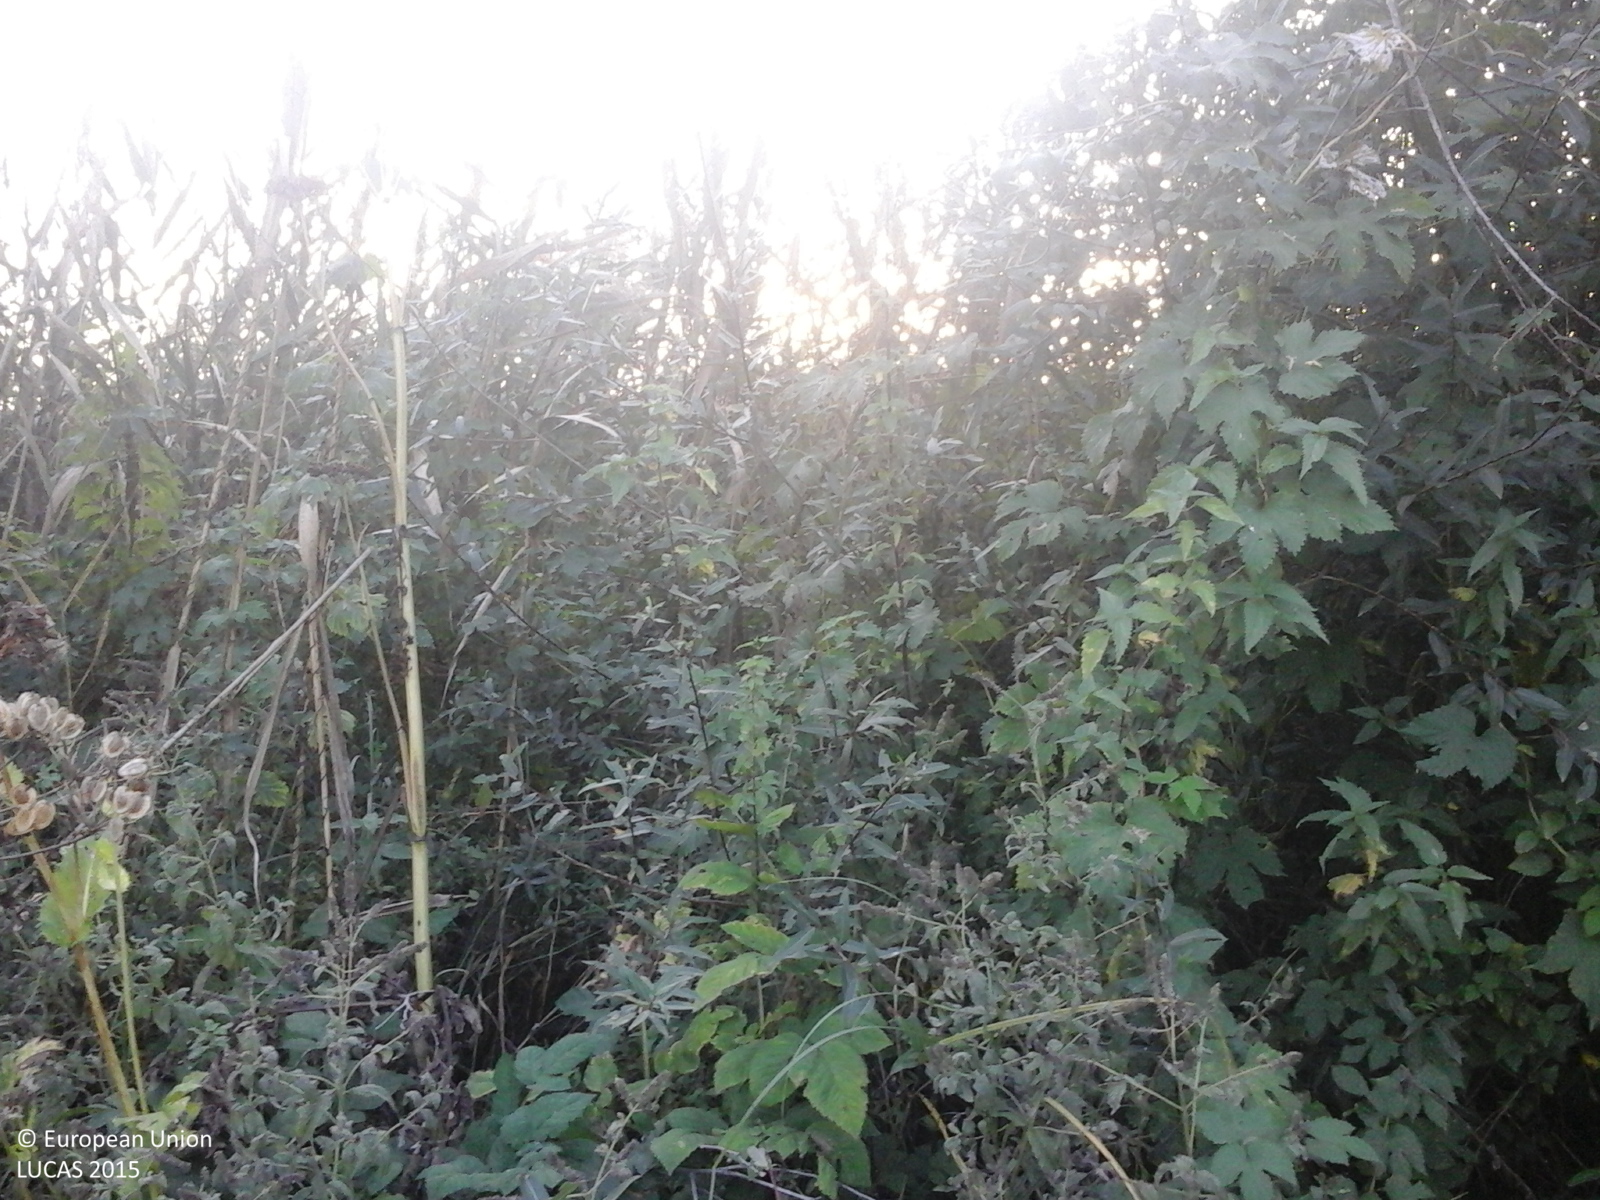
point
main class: Shrubland
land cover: Shrubland with sparse tree cover
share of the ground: > 75 %
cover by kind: shrubs 95 %, broadleaved forest trees 5 %
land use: Semi-natural and natural areas not in use
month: September
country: RO
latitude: 45.1626
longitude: 22.3172
